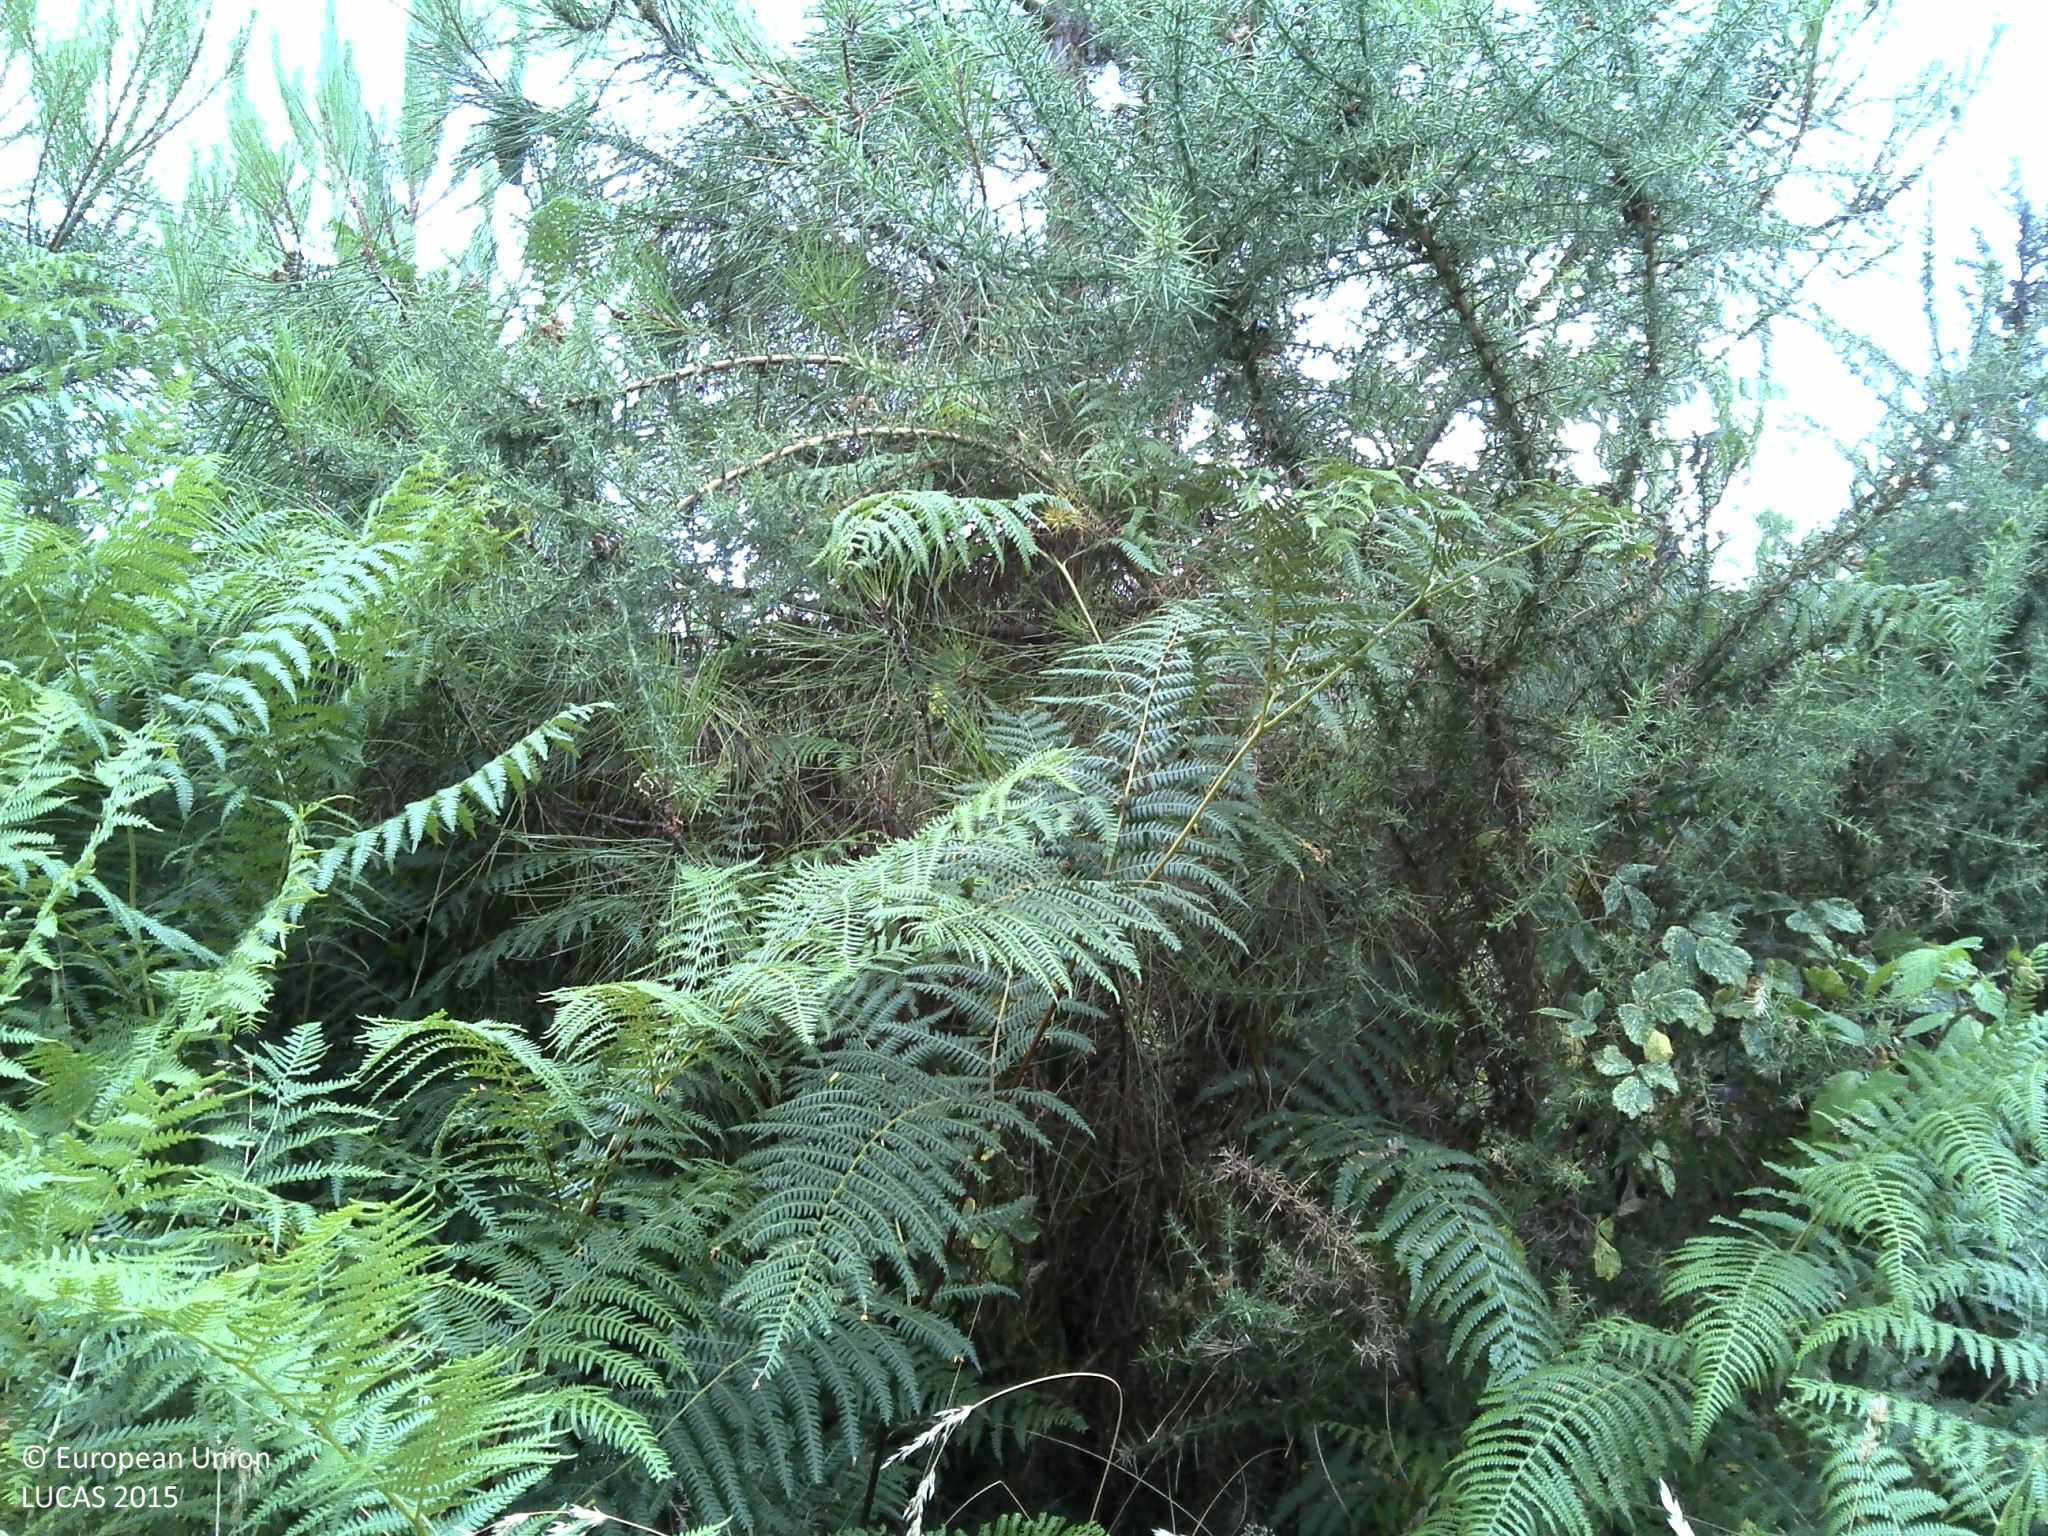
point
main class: Woodland
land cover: Pine dominated coniferous woodland
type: coniferous forest of the mediterranean region
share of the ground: > 75 %
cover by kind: coniferous forest trees 60 %, shrubs 35 %, herbaceous plants 5 %
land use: Forestry
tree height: < 5 m
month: July
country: FR
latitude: 44.9862
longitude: -0.7892
